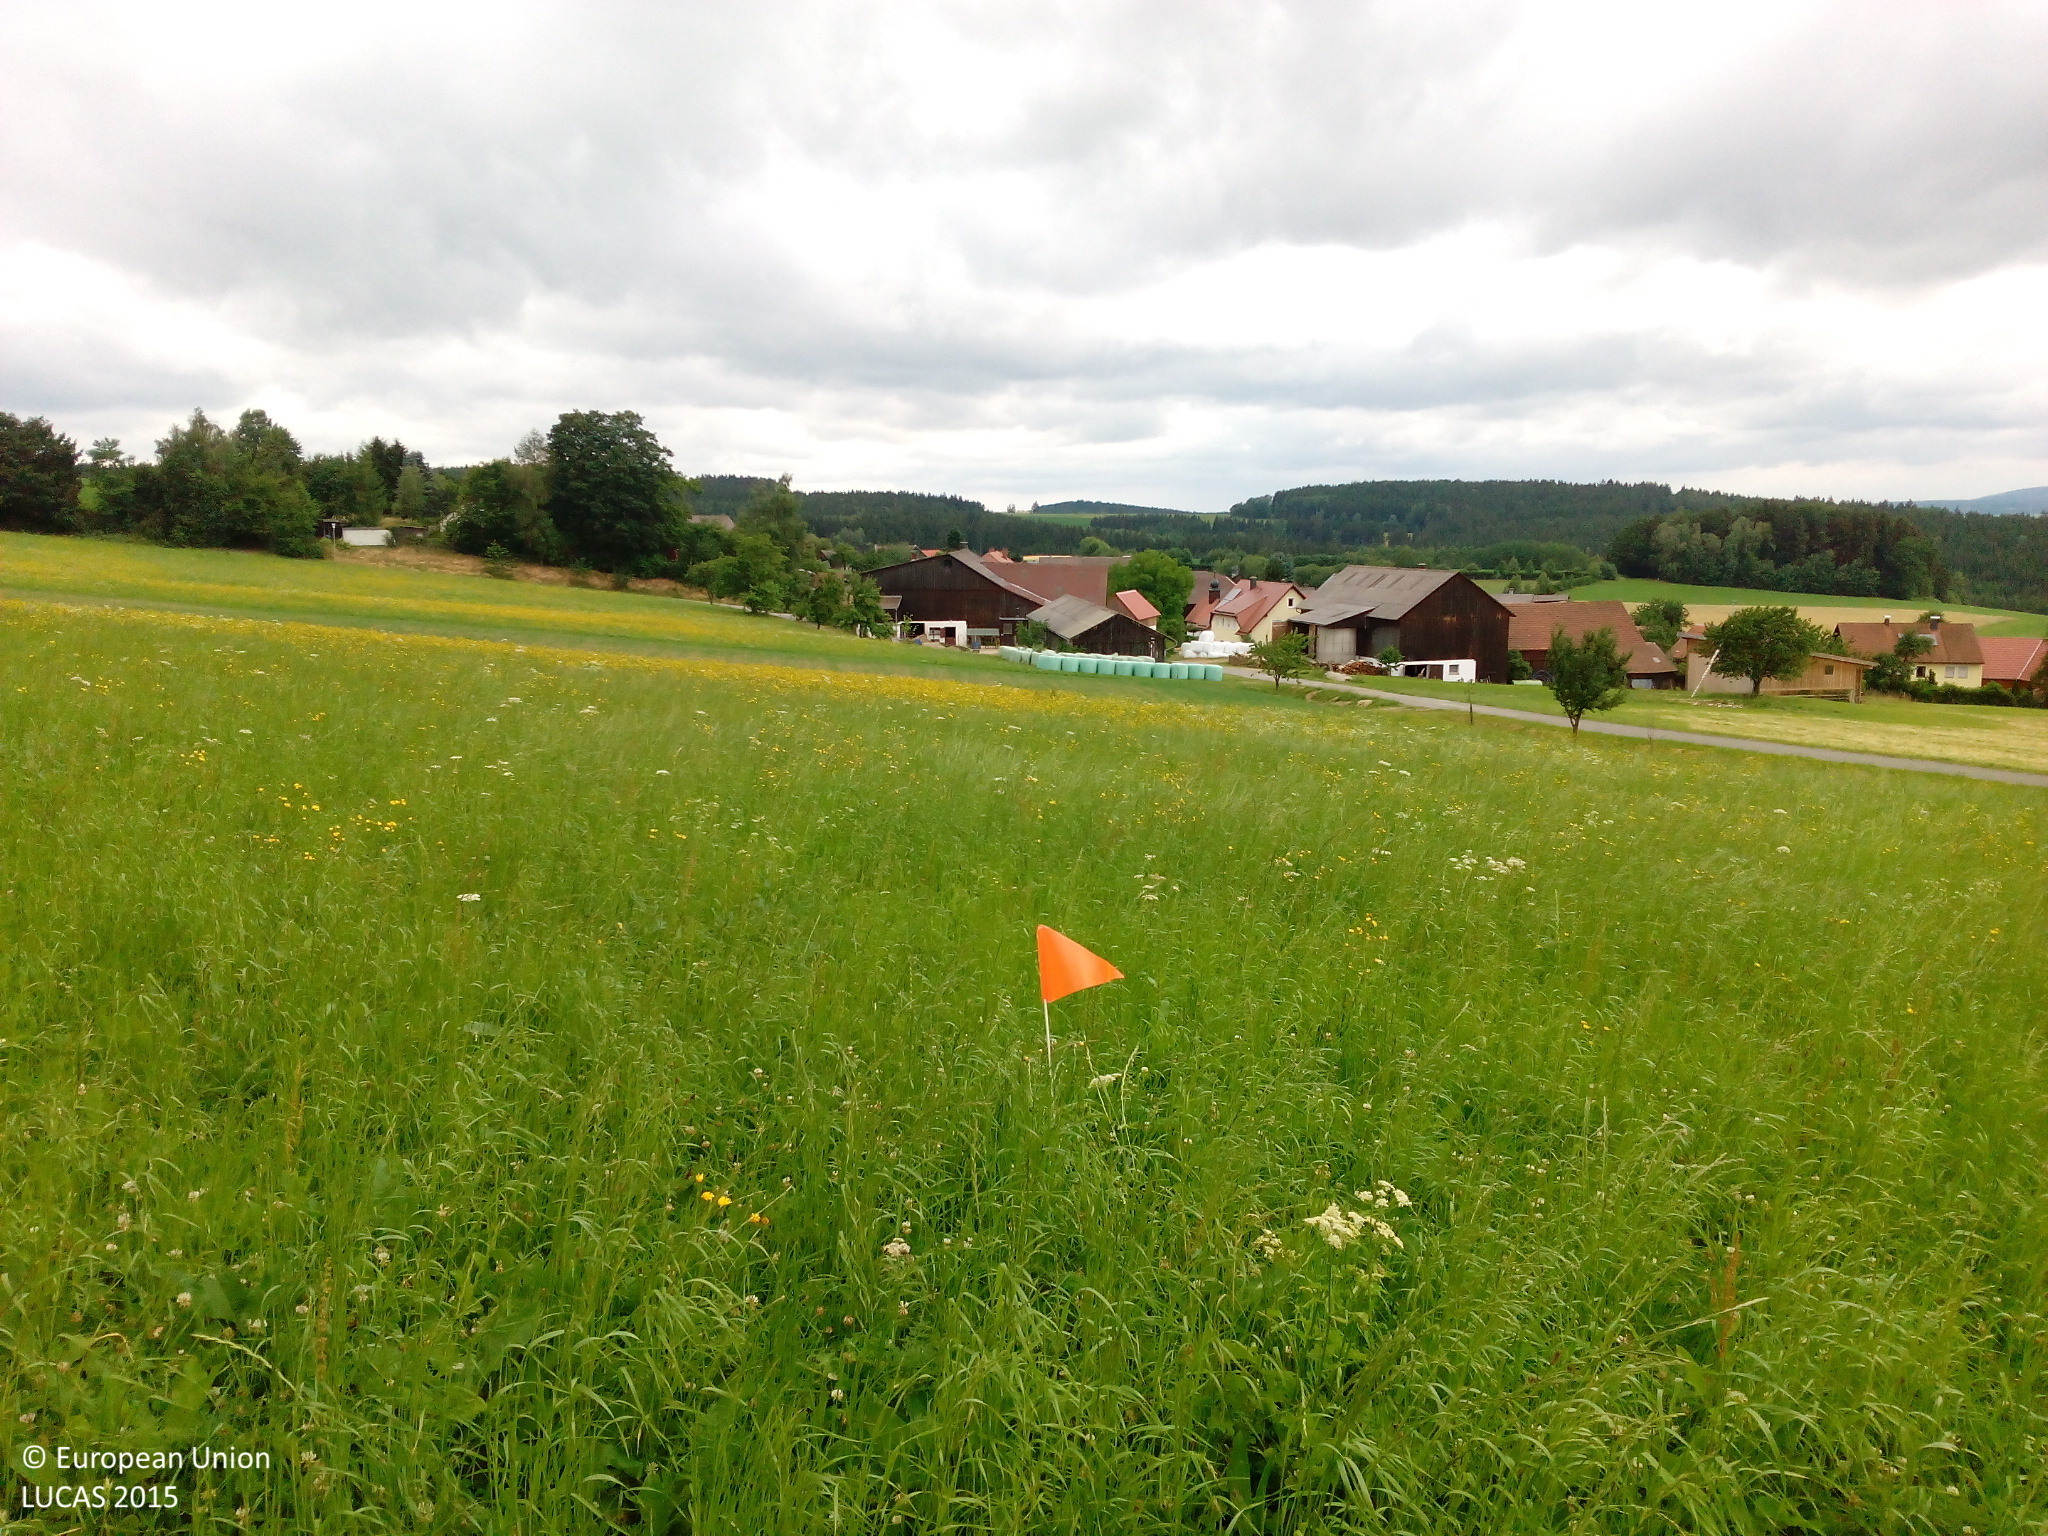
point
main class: Grassland
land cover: Grassland without tree/shrub cover
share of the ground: > 75 %
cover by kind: herbaceous plants 100 %
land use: Agriculture (excluding fallow land and kitchen gardens)
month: July
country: DE
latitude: 49.5469
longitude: 12.4183
